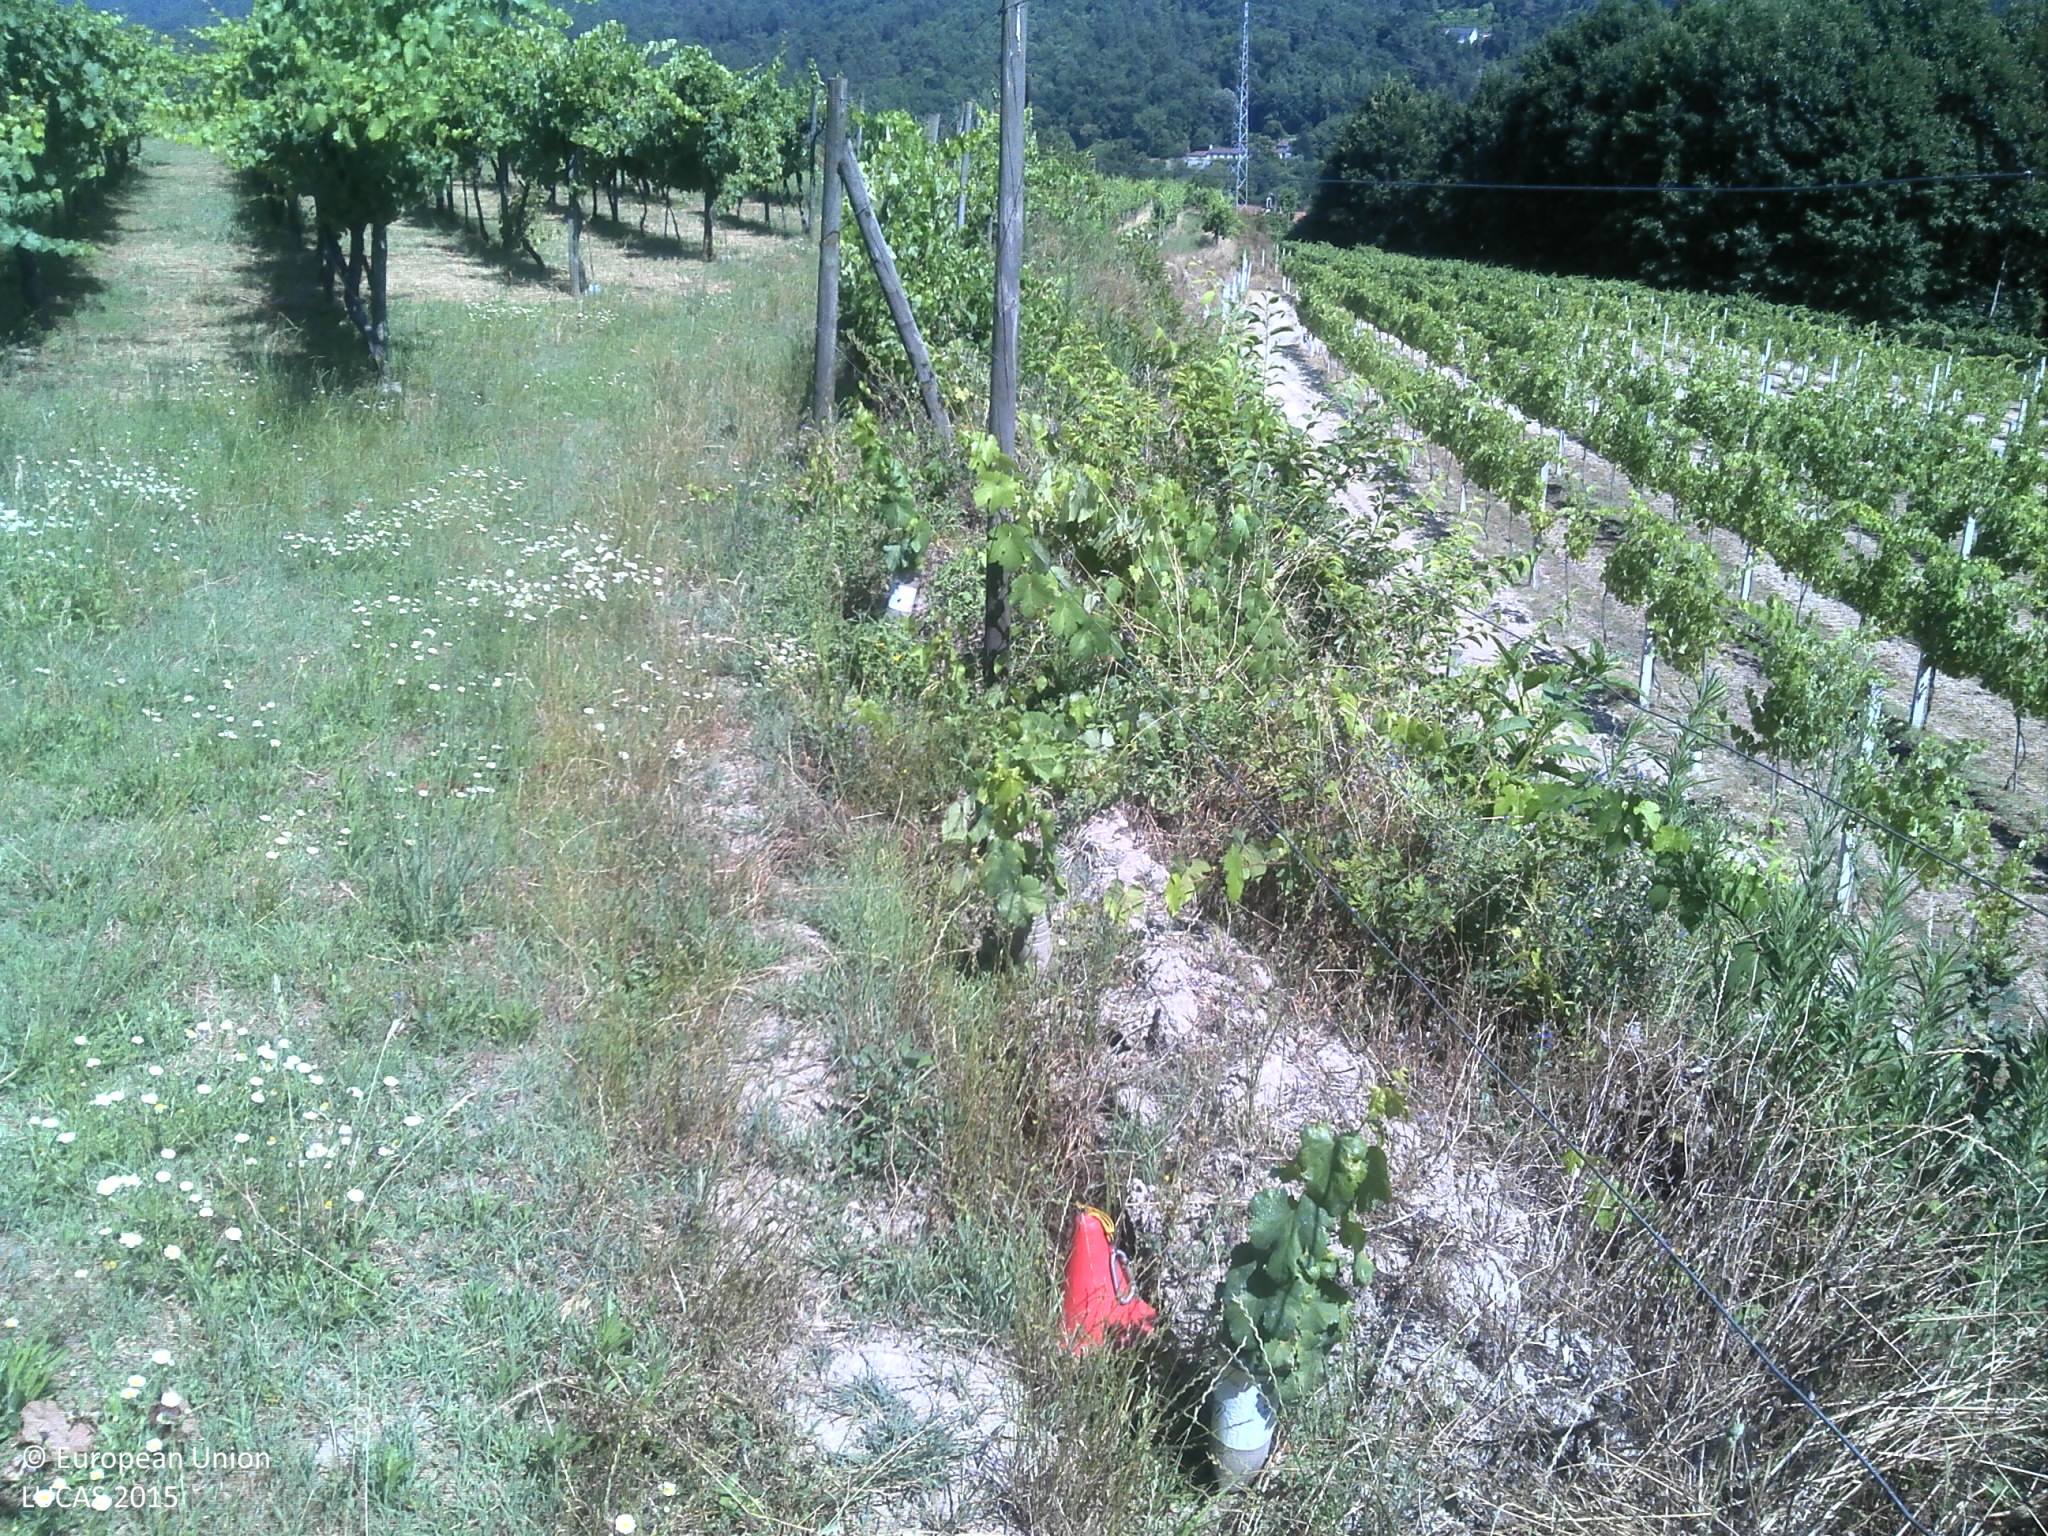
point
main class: Cropland
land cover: Vineyards
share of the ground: 10 - 25 %
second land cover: Grassland without tree/shrub cover
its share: 25 - 50 %
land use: Agriculture (excluding fallow land and kitchen gardens)
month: June
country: PT
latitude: 41.2910
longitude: -8.0628
